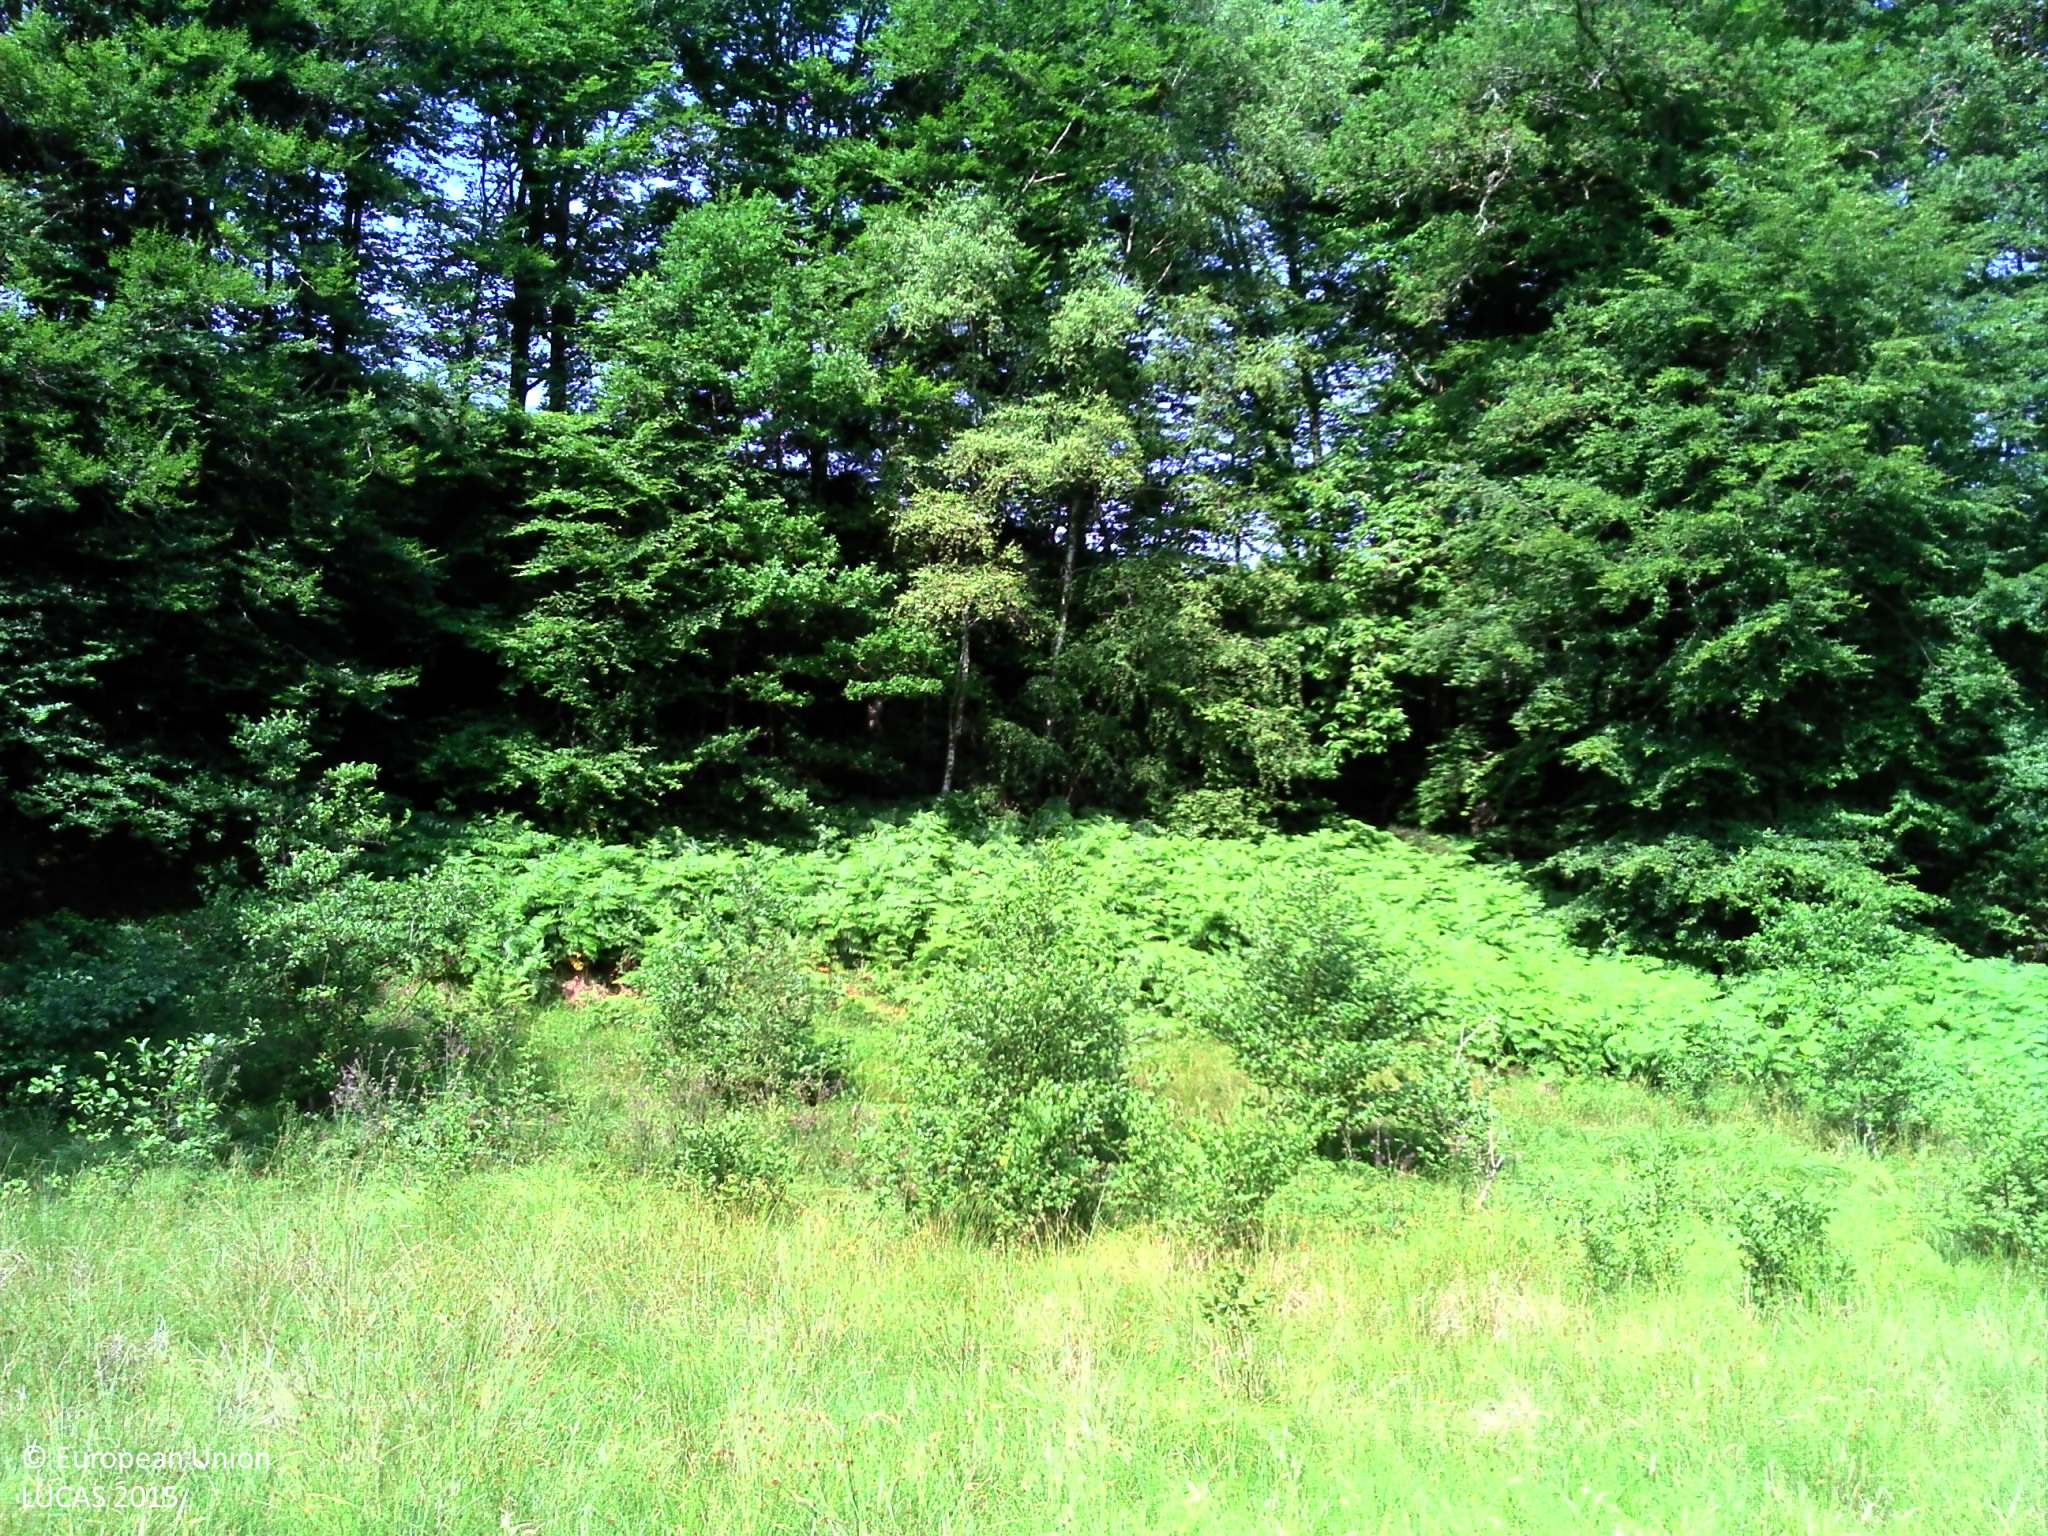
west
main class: Grassland
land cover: Grassland without tree/shrub cover
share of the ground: > 75 %
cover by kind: herbaceous plants 100 %
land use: Agriculture (excluding fallow land and kitchen gardens)
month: July
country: FR
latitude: 45.8005
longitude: 1.7982
